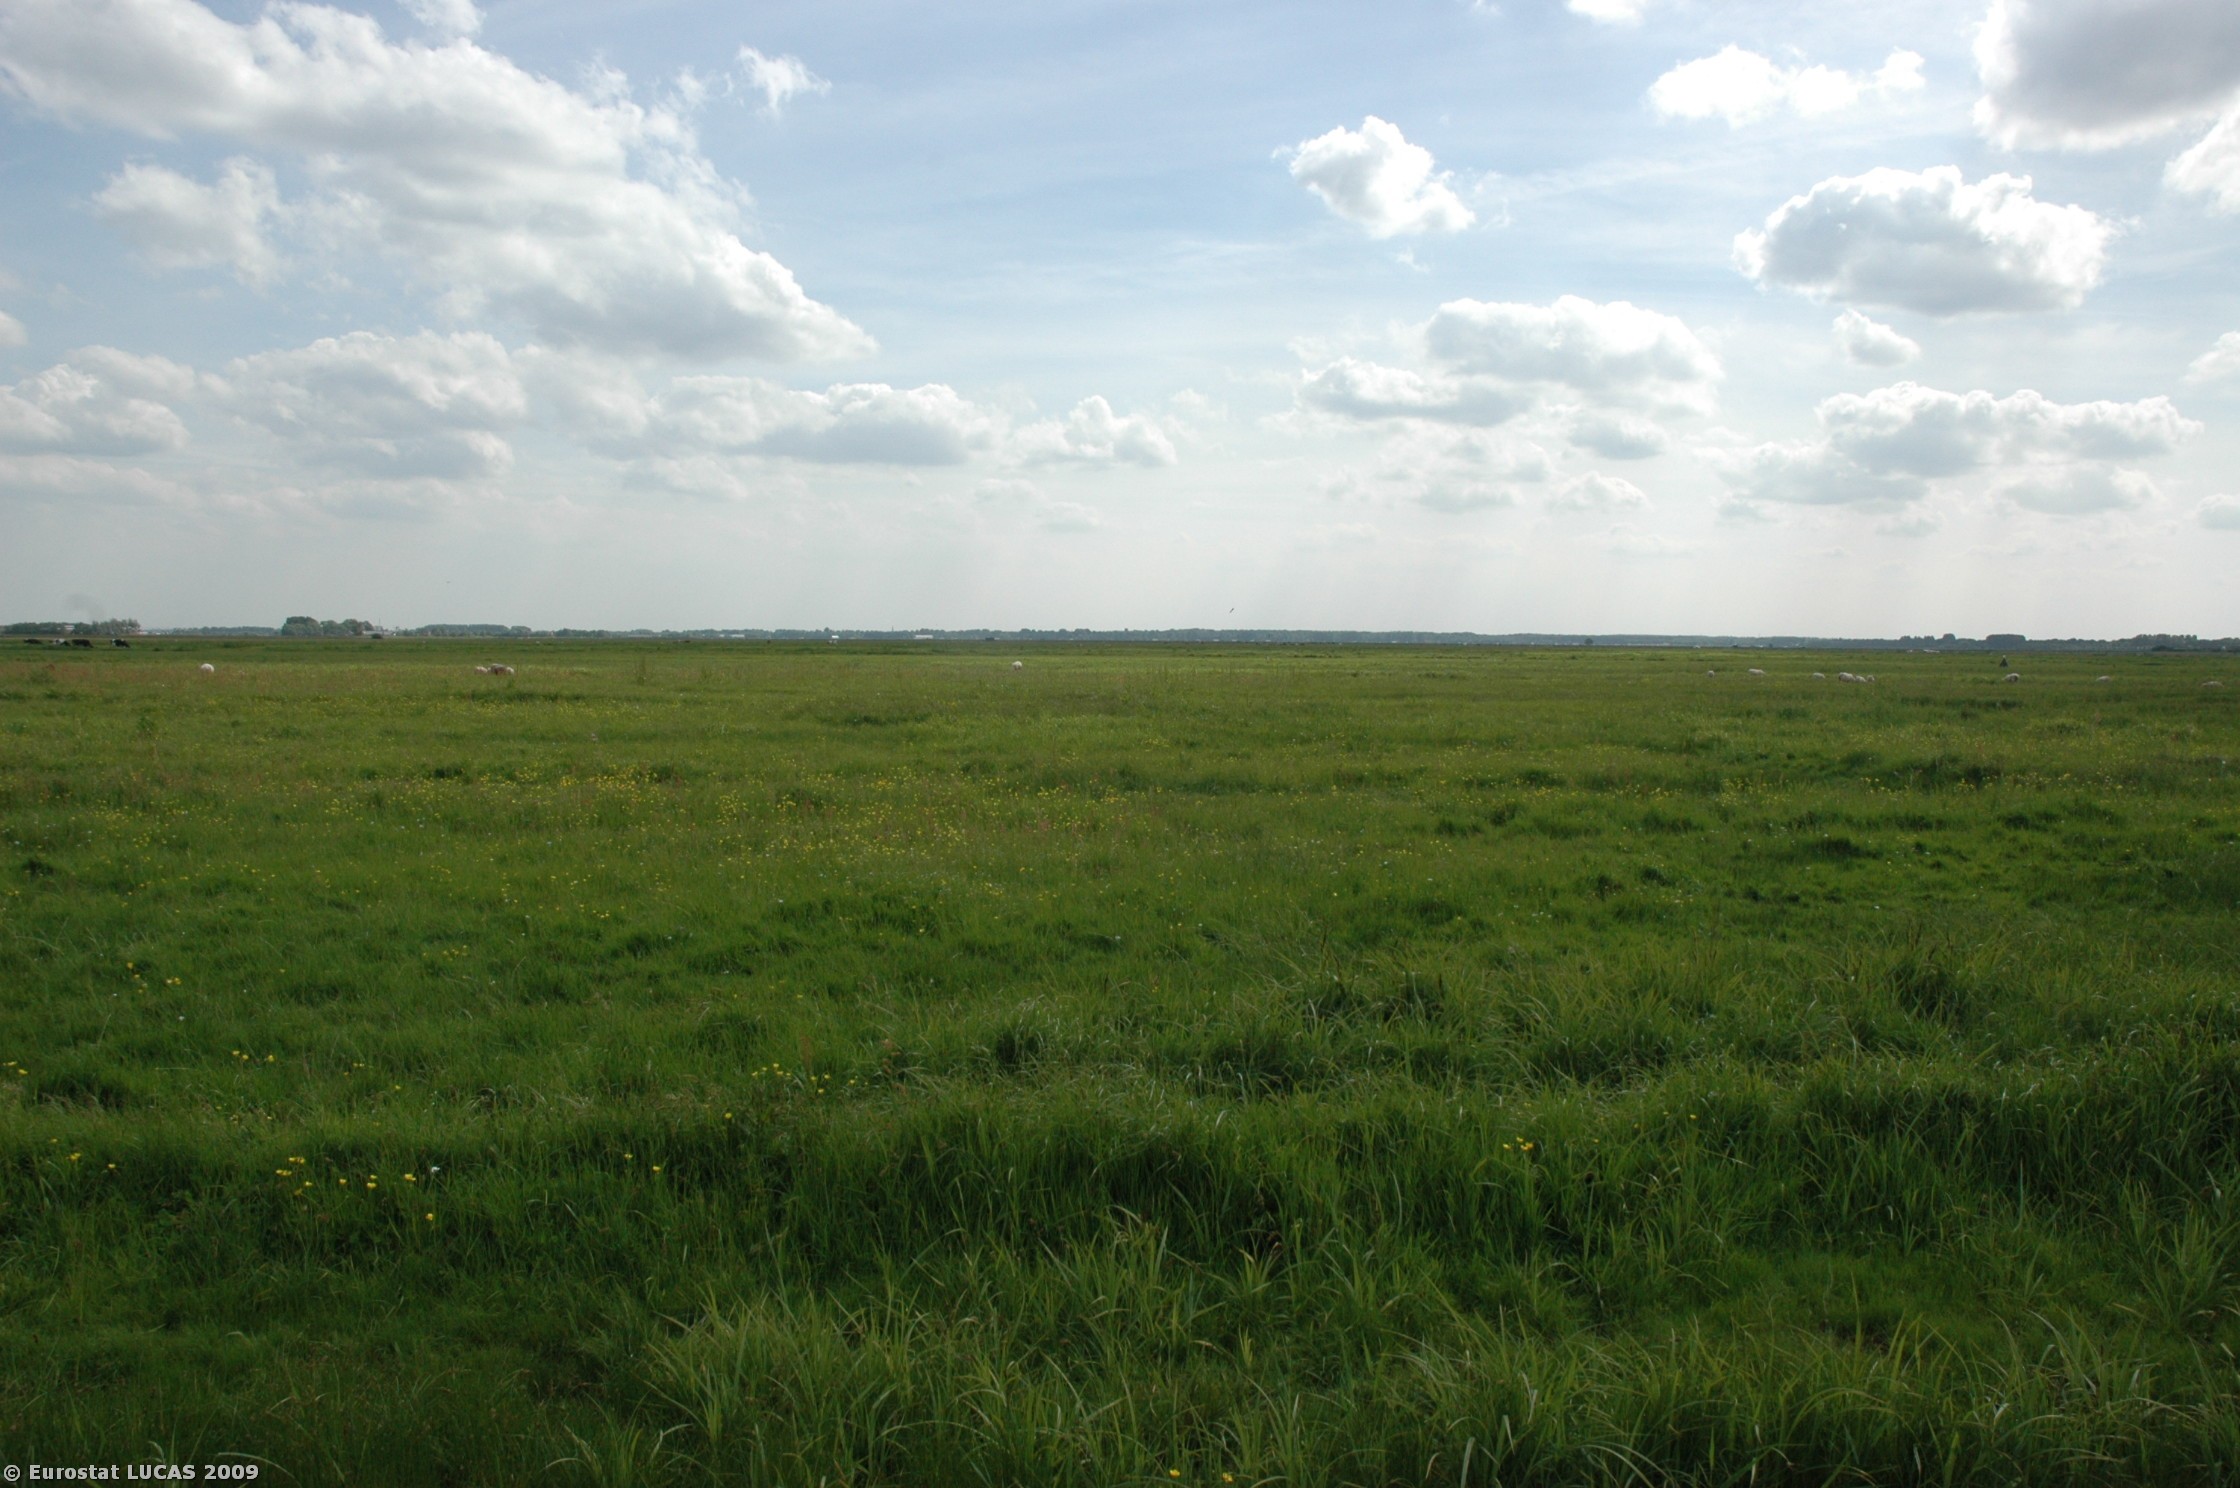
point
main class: Grassland
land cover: Grassland without tree/shrub cover
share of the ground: > 75 %
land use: Agriculture (excluding fallow land and kitchen gardens)
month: May
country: NL
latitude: 52.2662
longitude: 5.2943
